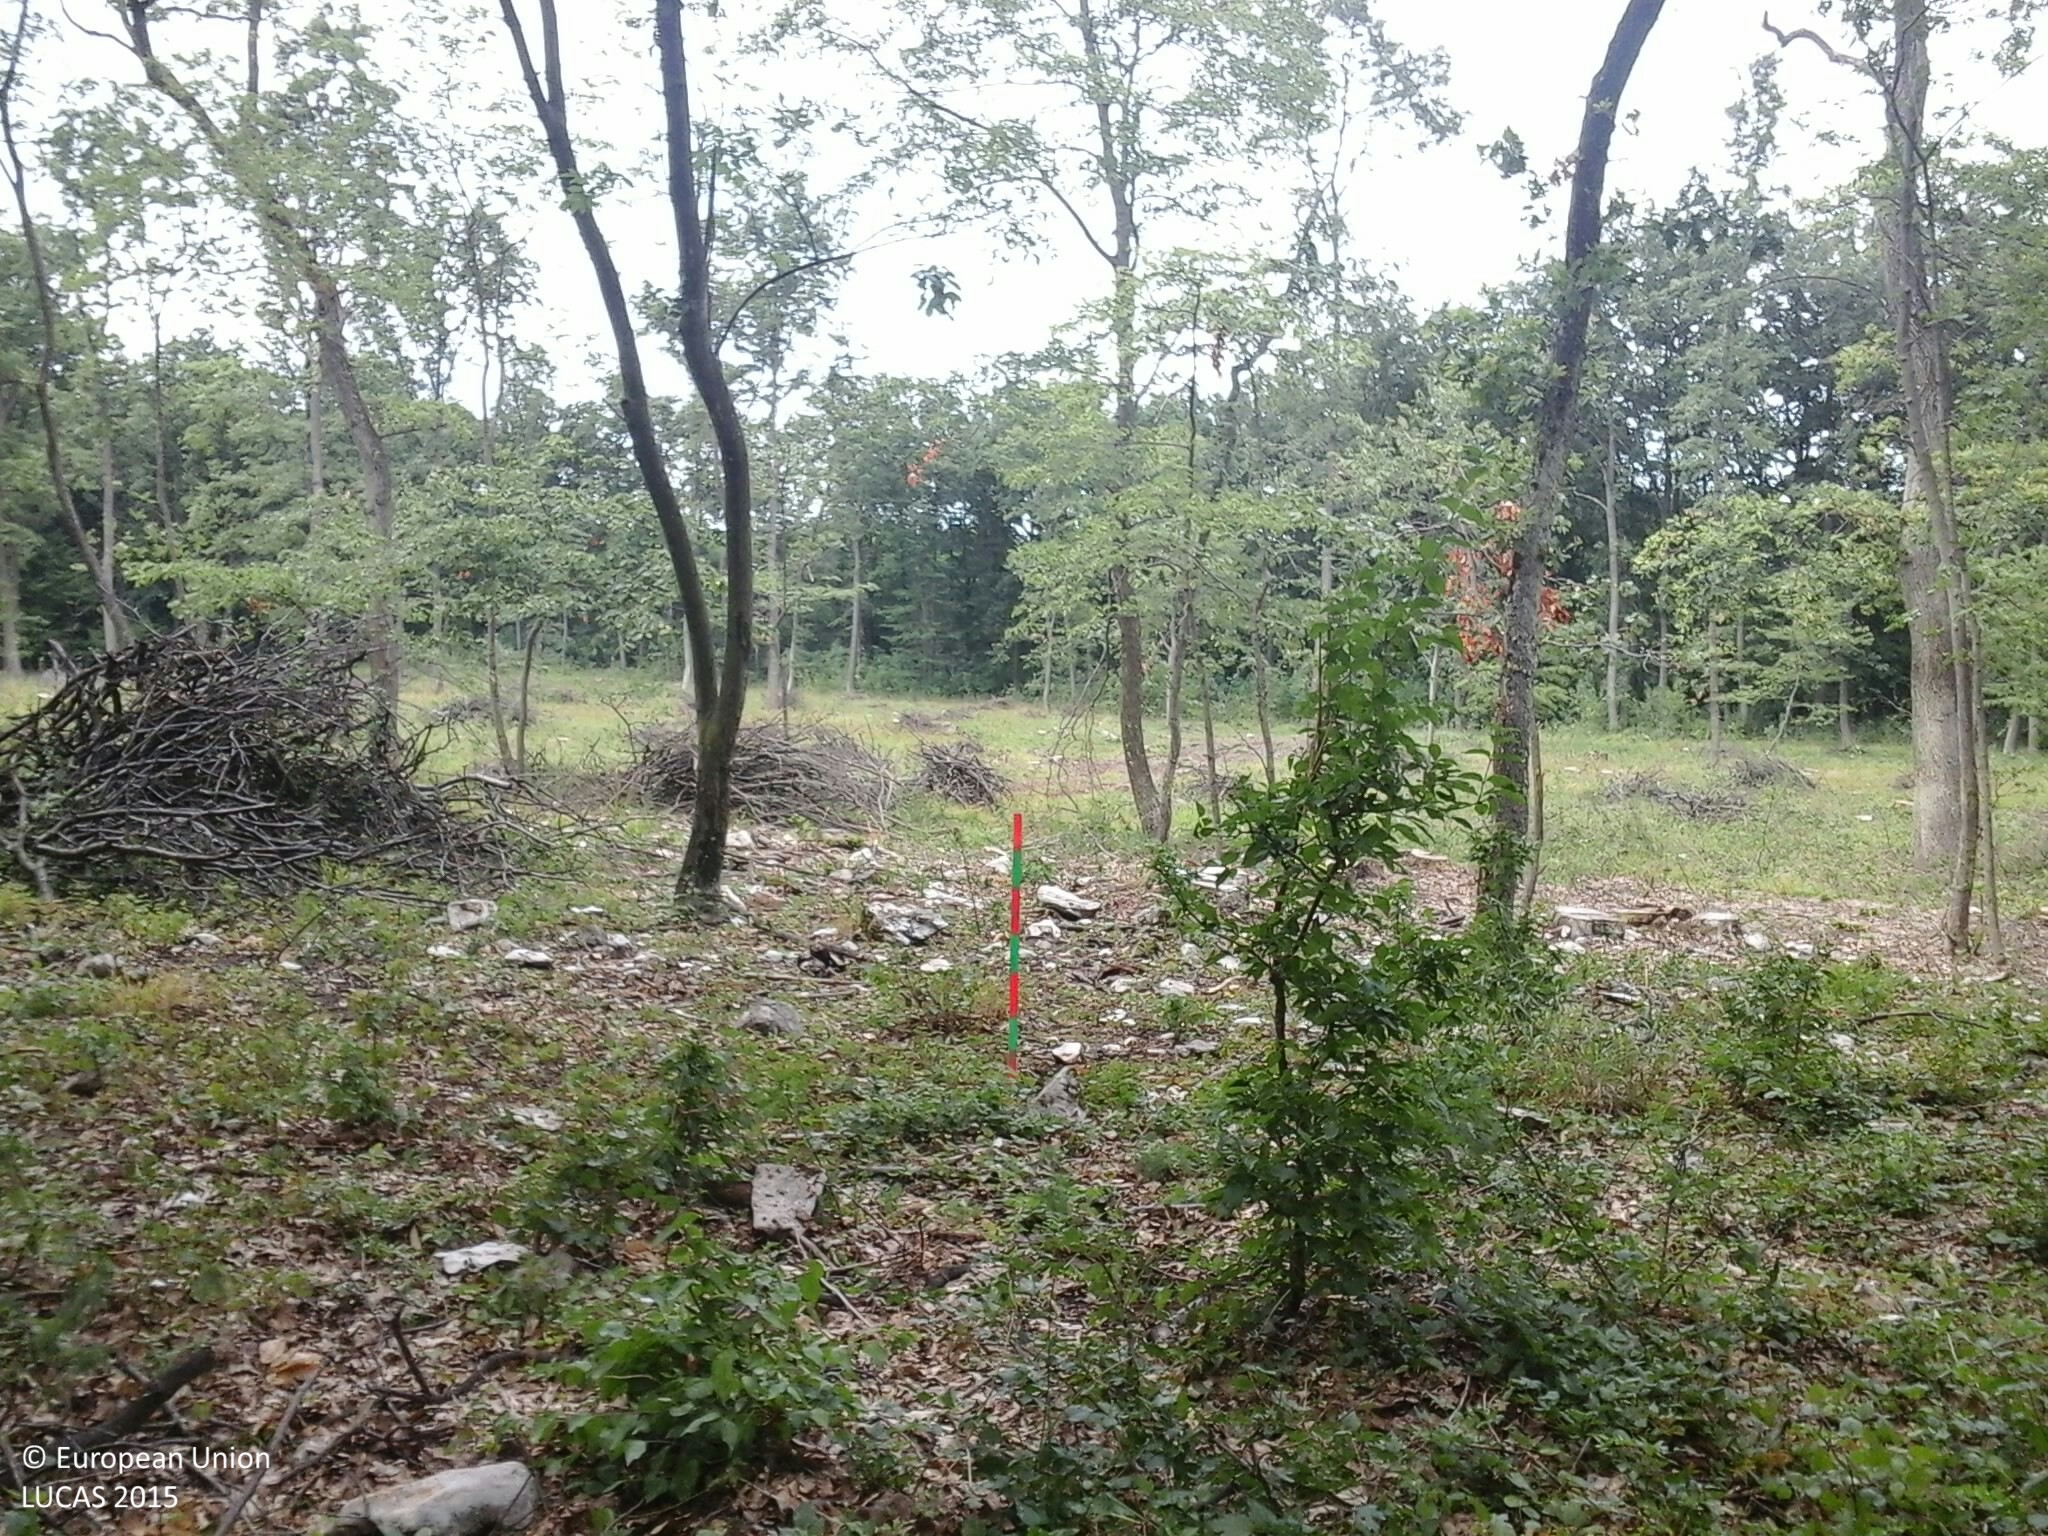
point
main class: Woodland
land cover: Broadleaved woodland
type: acidophilous oak and oak-birch forest
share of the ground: 50 - 75 %
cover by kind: broadleaved forest trees 75 %, herbaceous plants 15 %, consolidated bare surface 10 %
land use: Forestry
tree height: > 5 m
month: July
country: HU
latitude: 46.9563
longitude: 17.7473
